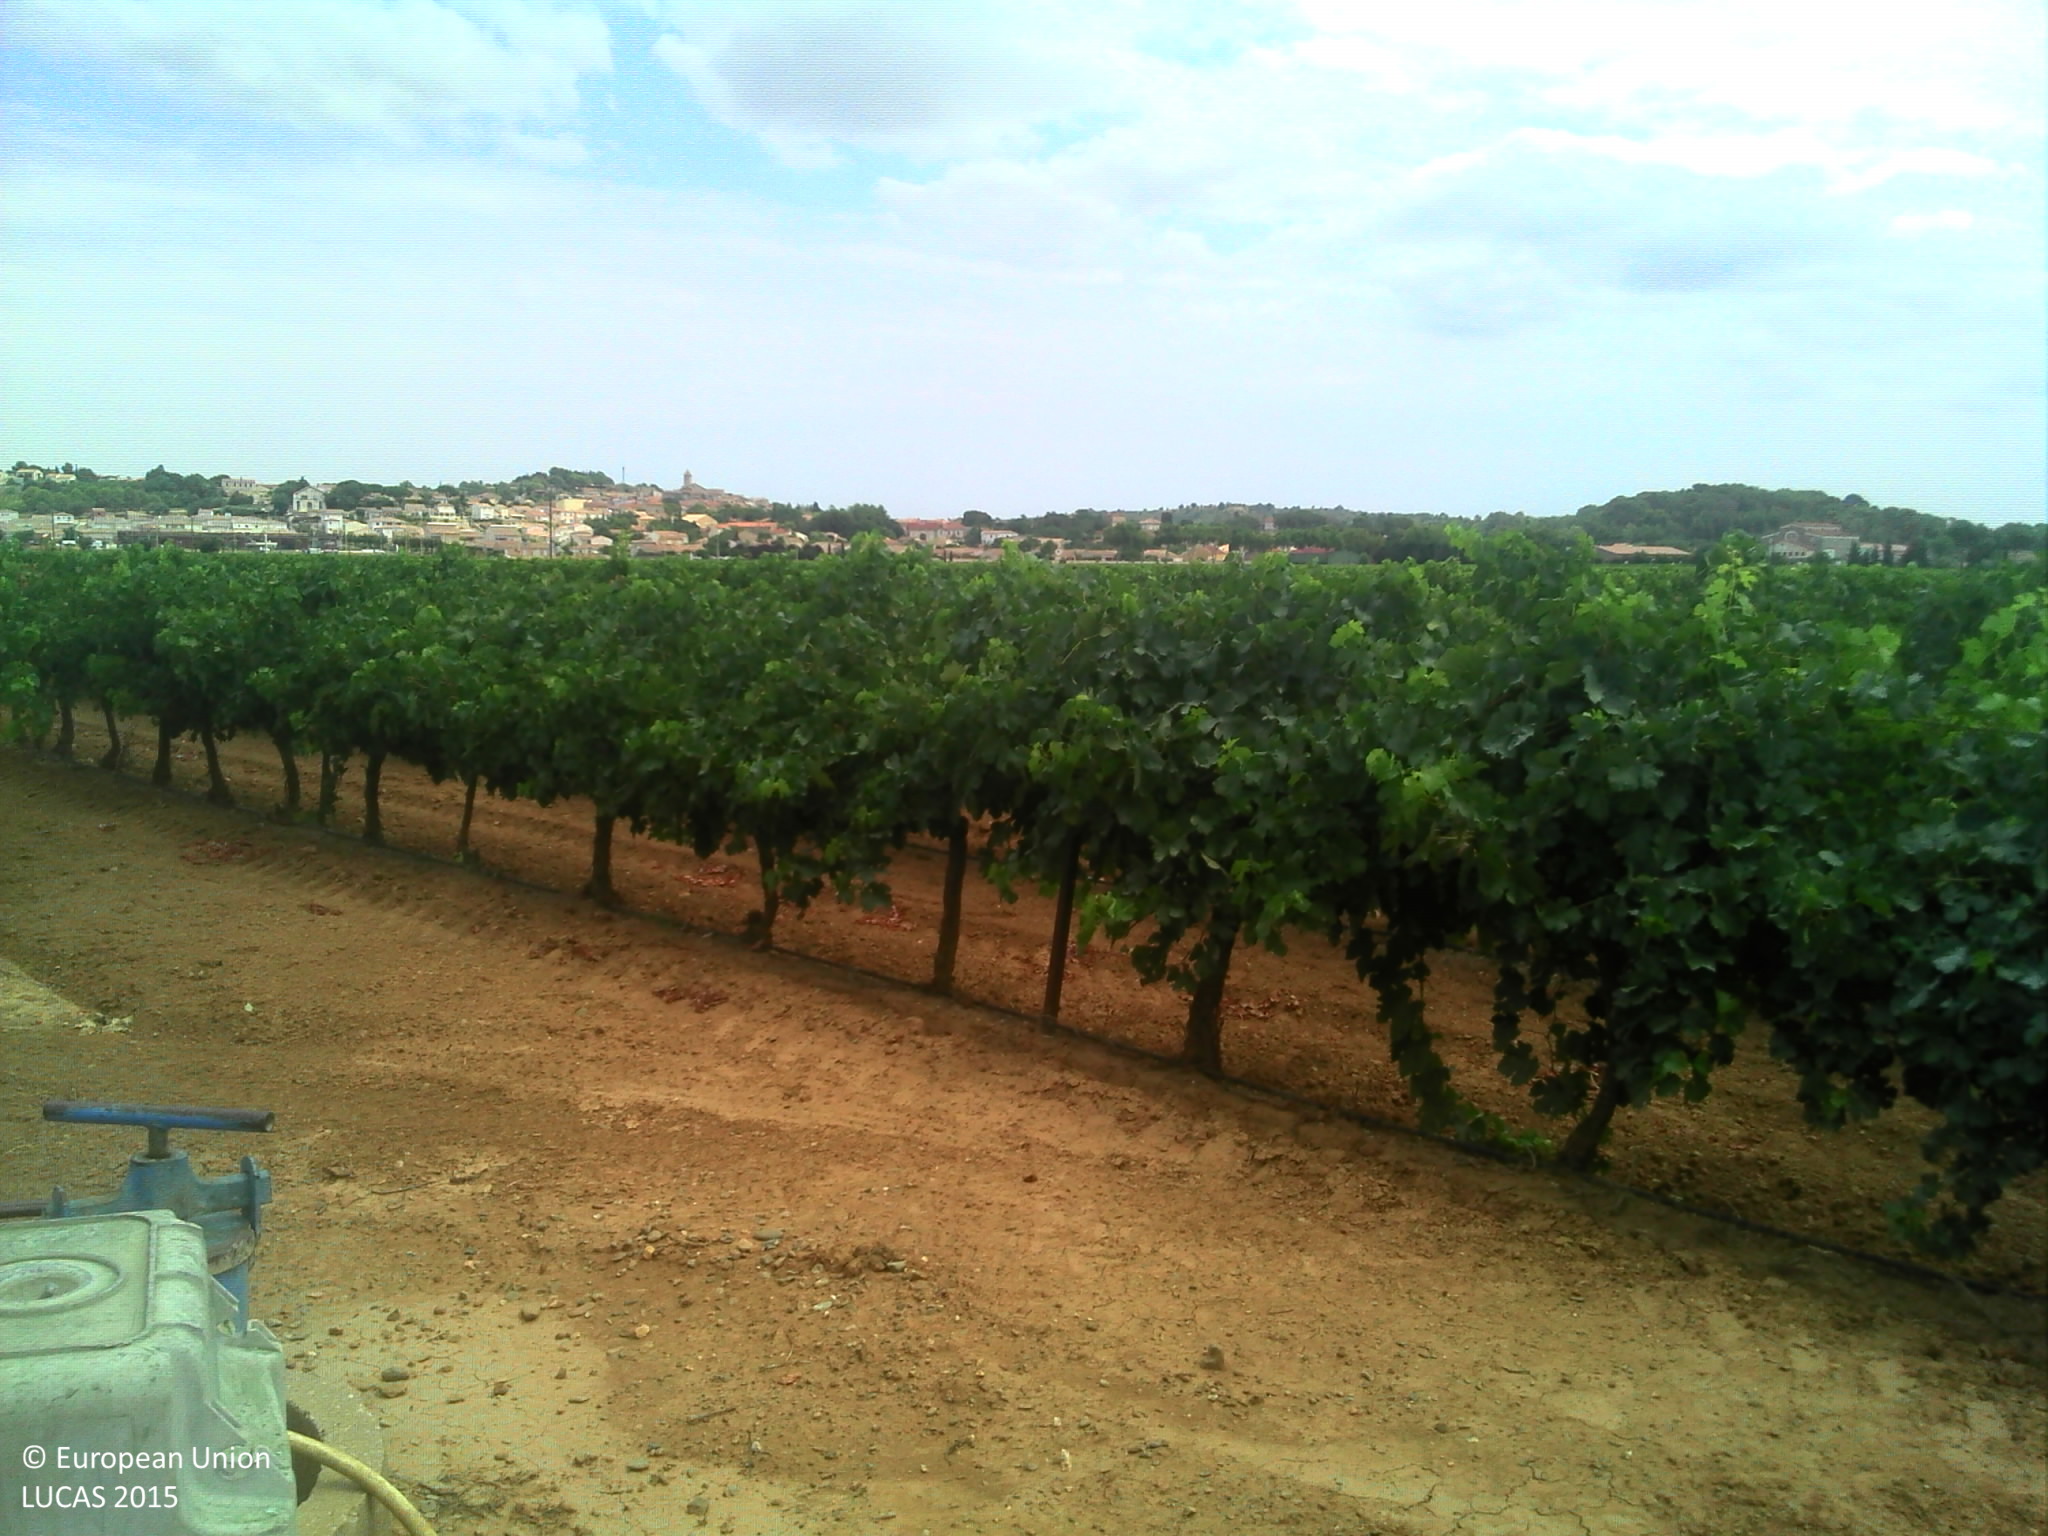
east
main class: Cropland
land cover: Vineyards
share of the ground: 25 - 50 %
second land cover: Other bare soil
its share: > 75 %
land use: Agriculture (excluding fallow land and kitchen gardens)
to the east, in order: Vineyards; Other bare soil; Tracks; Vineyards
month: July
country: FR
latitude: 43.4184
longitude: 3.1542
